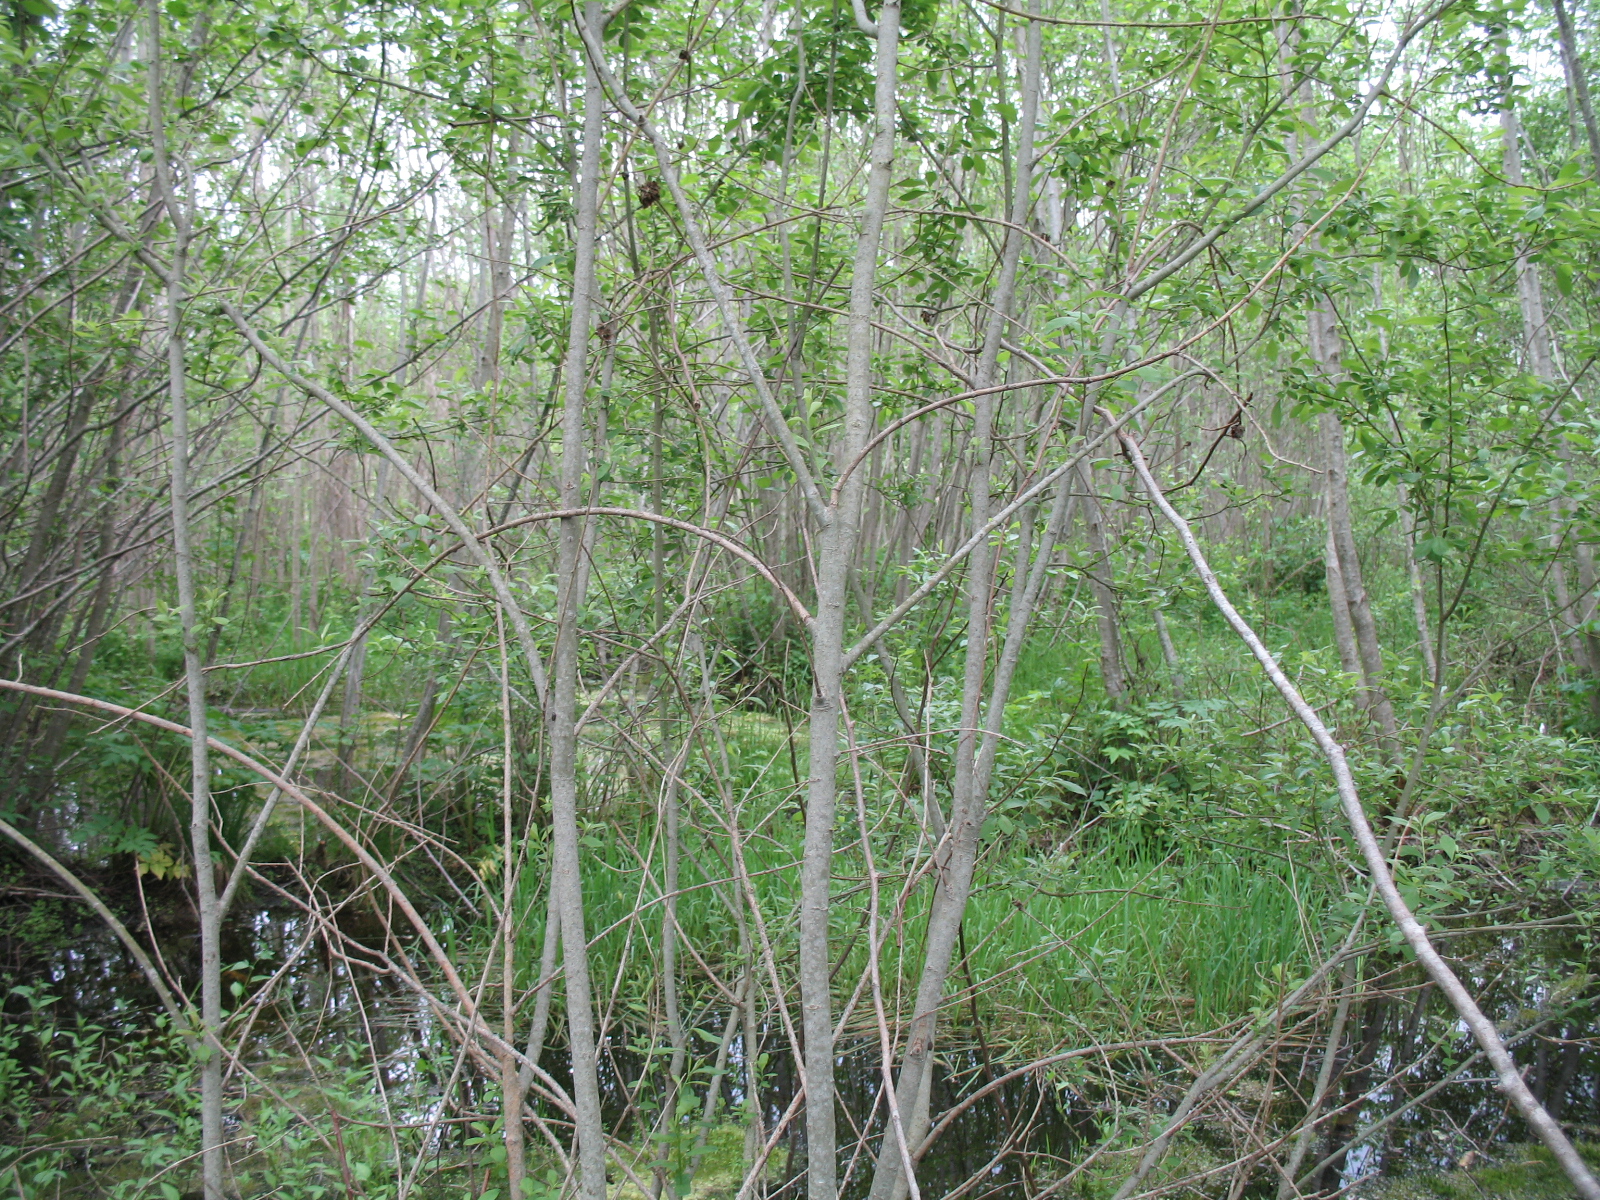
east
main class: Woodland
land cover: Broadleaved woodland
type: mire and swamp forests
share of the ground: > 75 %
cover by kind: broadleaved forest trees 95 %, herbaceous plants 5 %
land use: Forestry
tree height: > 5 m
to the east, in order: Broadleaved woodland; Shrubland with sparse tree cover; Spontaneously vegetated surfaces; Ditches and canals; Spontaneously vegetated surfaces; Broadleaved woodland
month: May
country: LV
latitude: 56.7451
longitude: 23.5315
